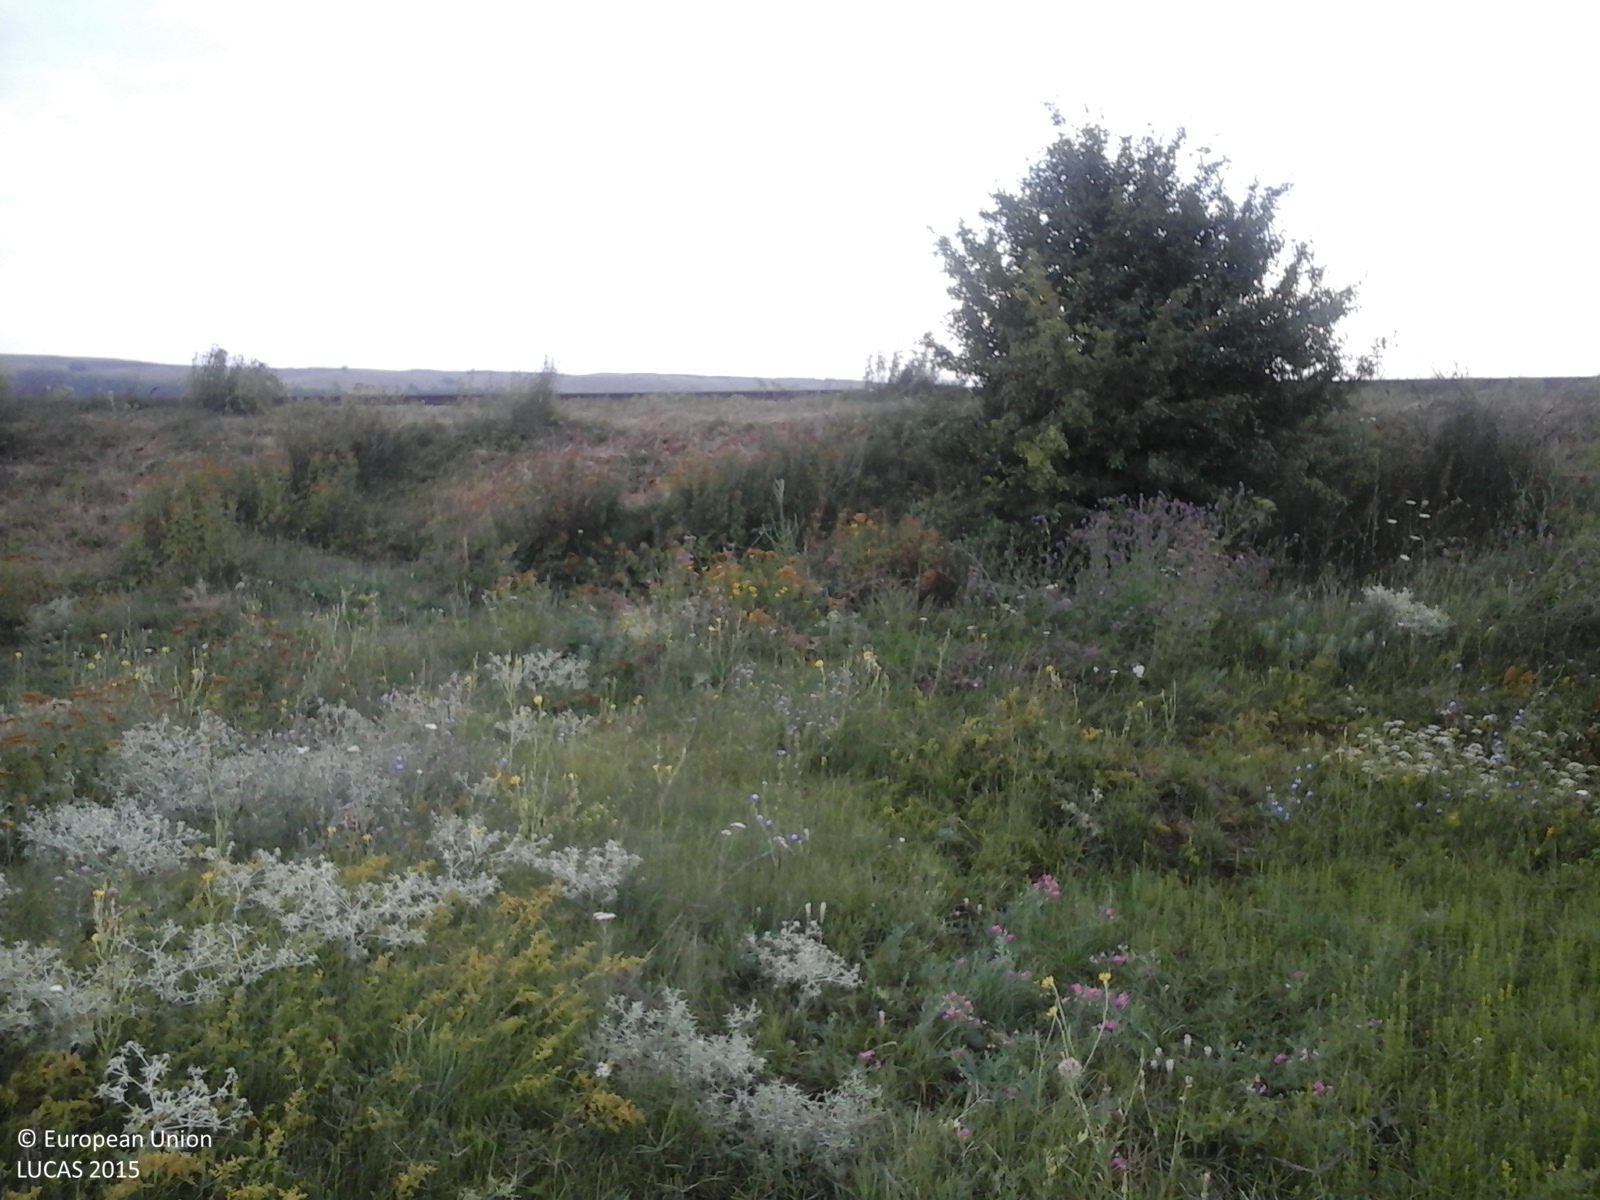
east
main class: Grassland
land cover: Spontaneously vegetated surfaces
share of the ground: > 75 %
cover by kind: herbaceous plants 100 %
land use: Fallow land
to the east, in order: Spontaneously vegetated surfaces; Railways; Spontaneously vegetated surfaces; Tracks; Grass margins; Maize; Artificial constructions in urban areas
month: July
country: RO
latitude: 46.3527
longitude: 27.8055
